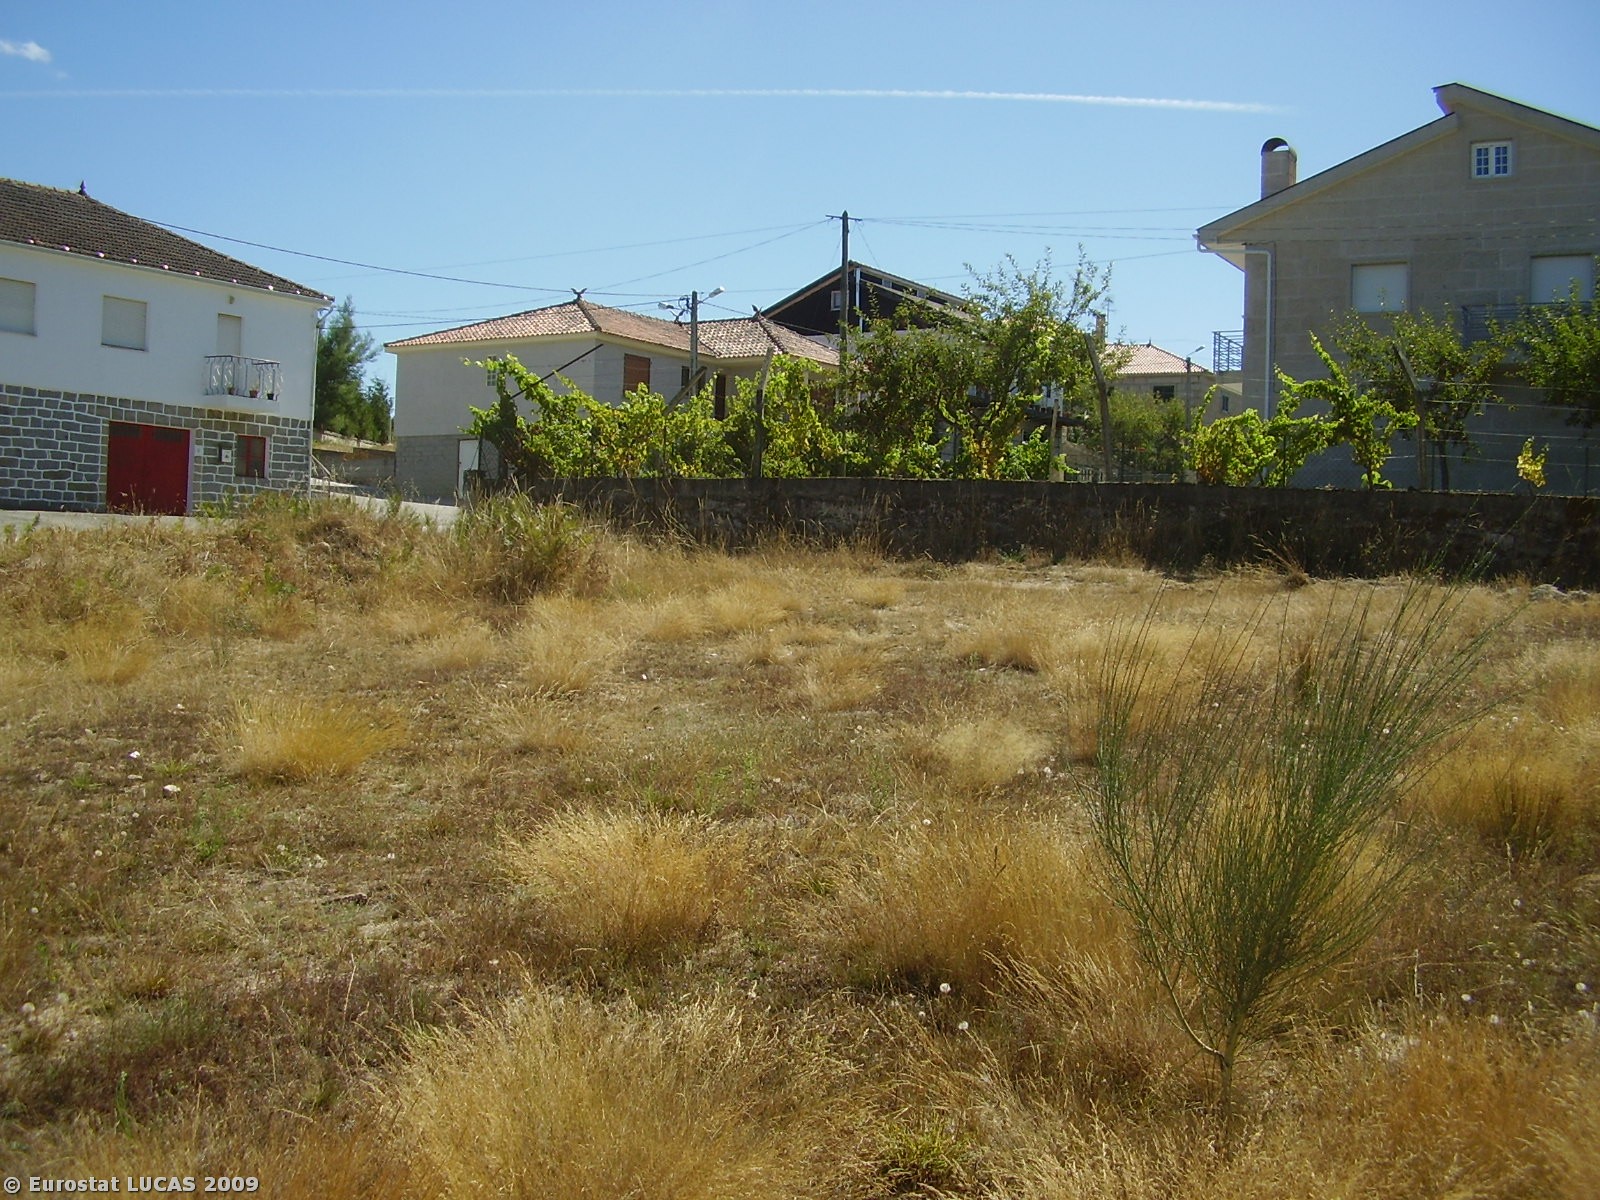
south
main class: Grassland
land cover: Spontaneously vegetated surfaces
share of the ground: > 75 %
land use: Fallow land
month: September
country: PT
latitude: 41.8481
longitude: -7.6364
